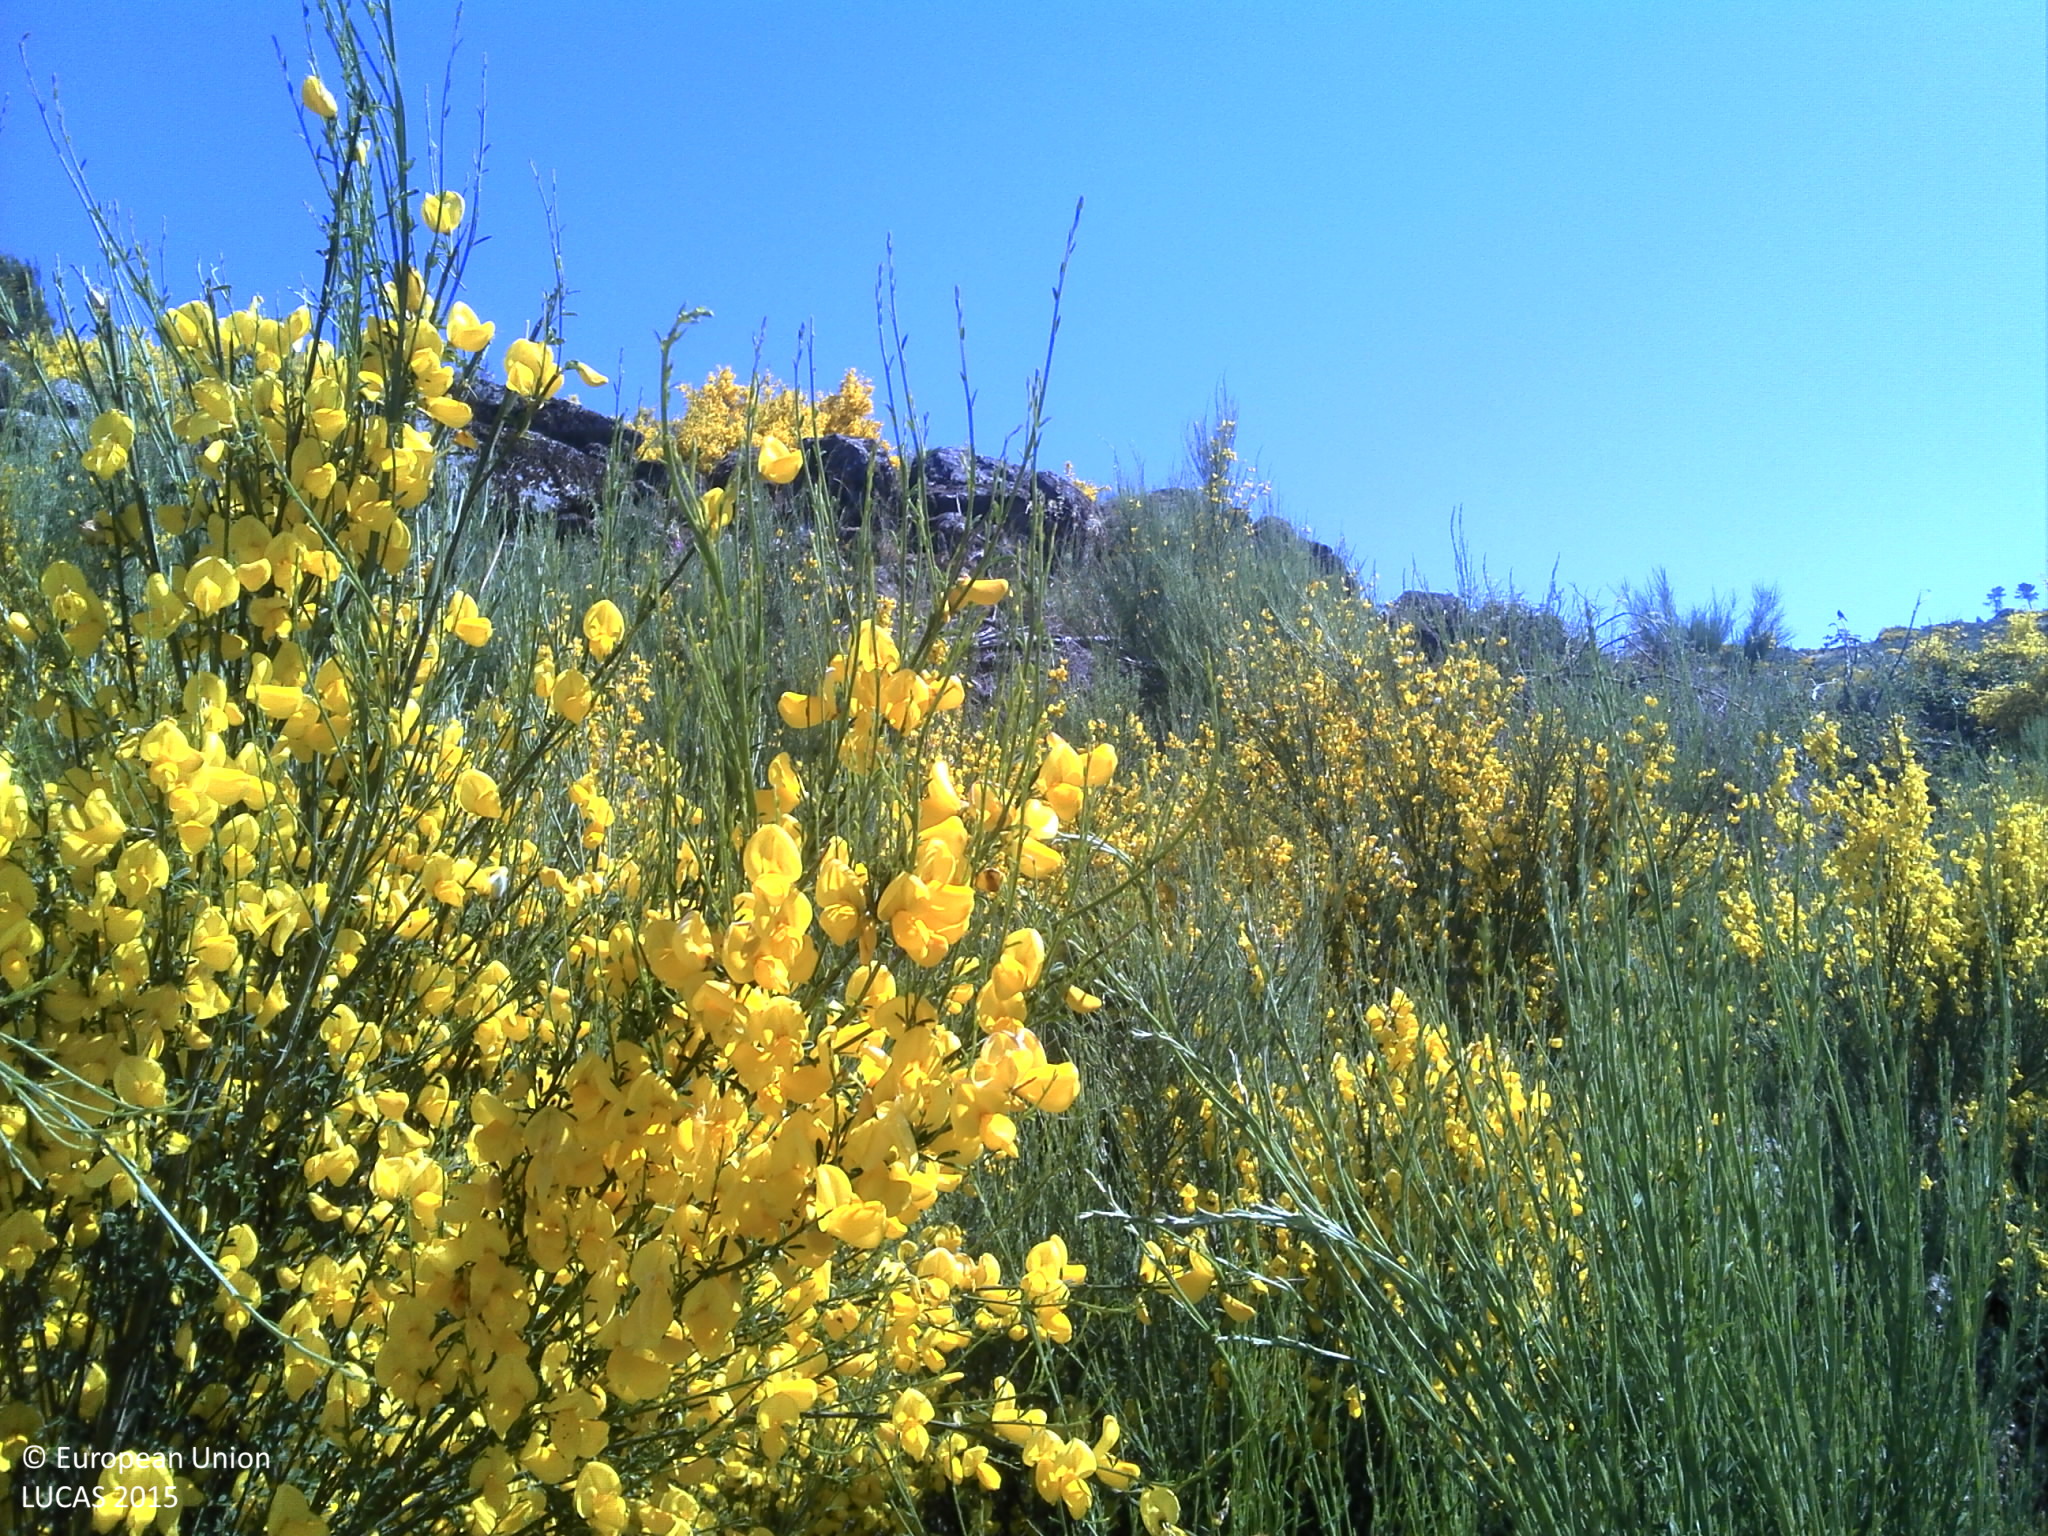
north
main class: Shrubland
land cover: Shrubland without tree cover
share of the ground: 25 - 50 %
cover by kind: shrubs 75 %, unconsolidated bare surface 20 %, herbaceous plants 5 %
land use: Agriculture (excluding fallow land and kitchen gardens)
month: May
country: PT
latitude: 40.5067
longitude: -7.3001
